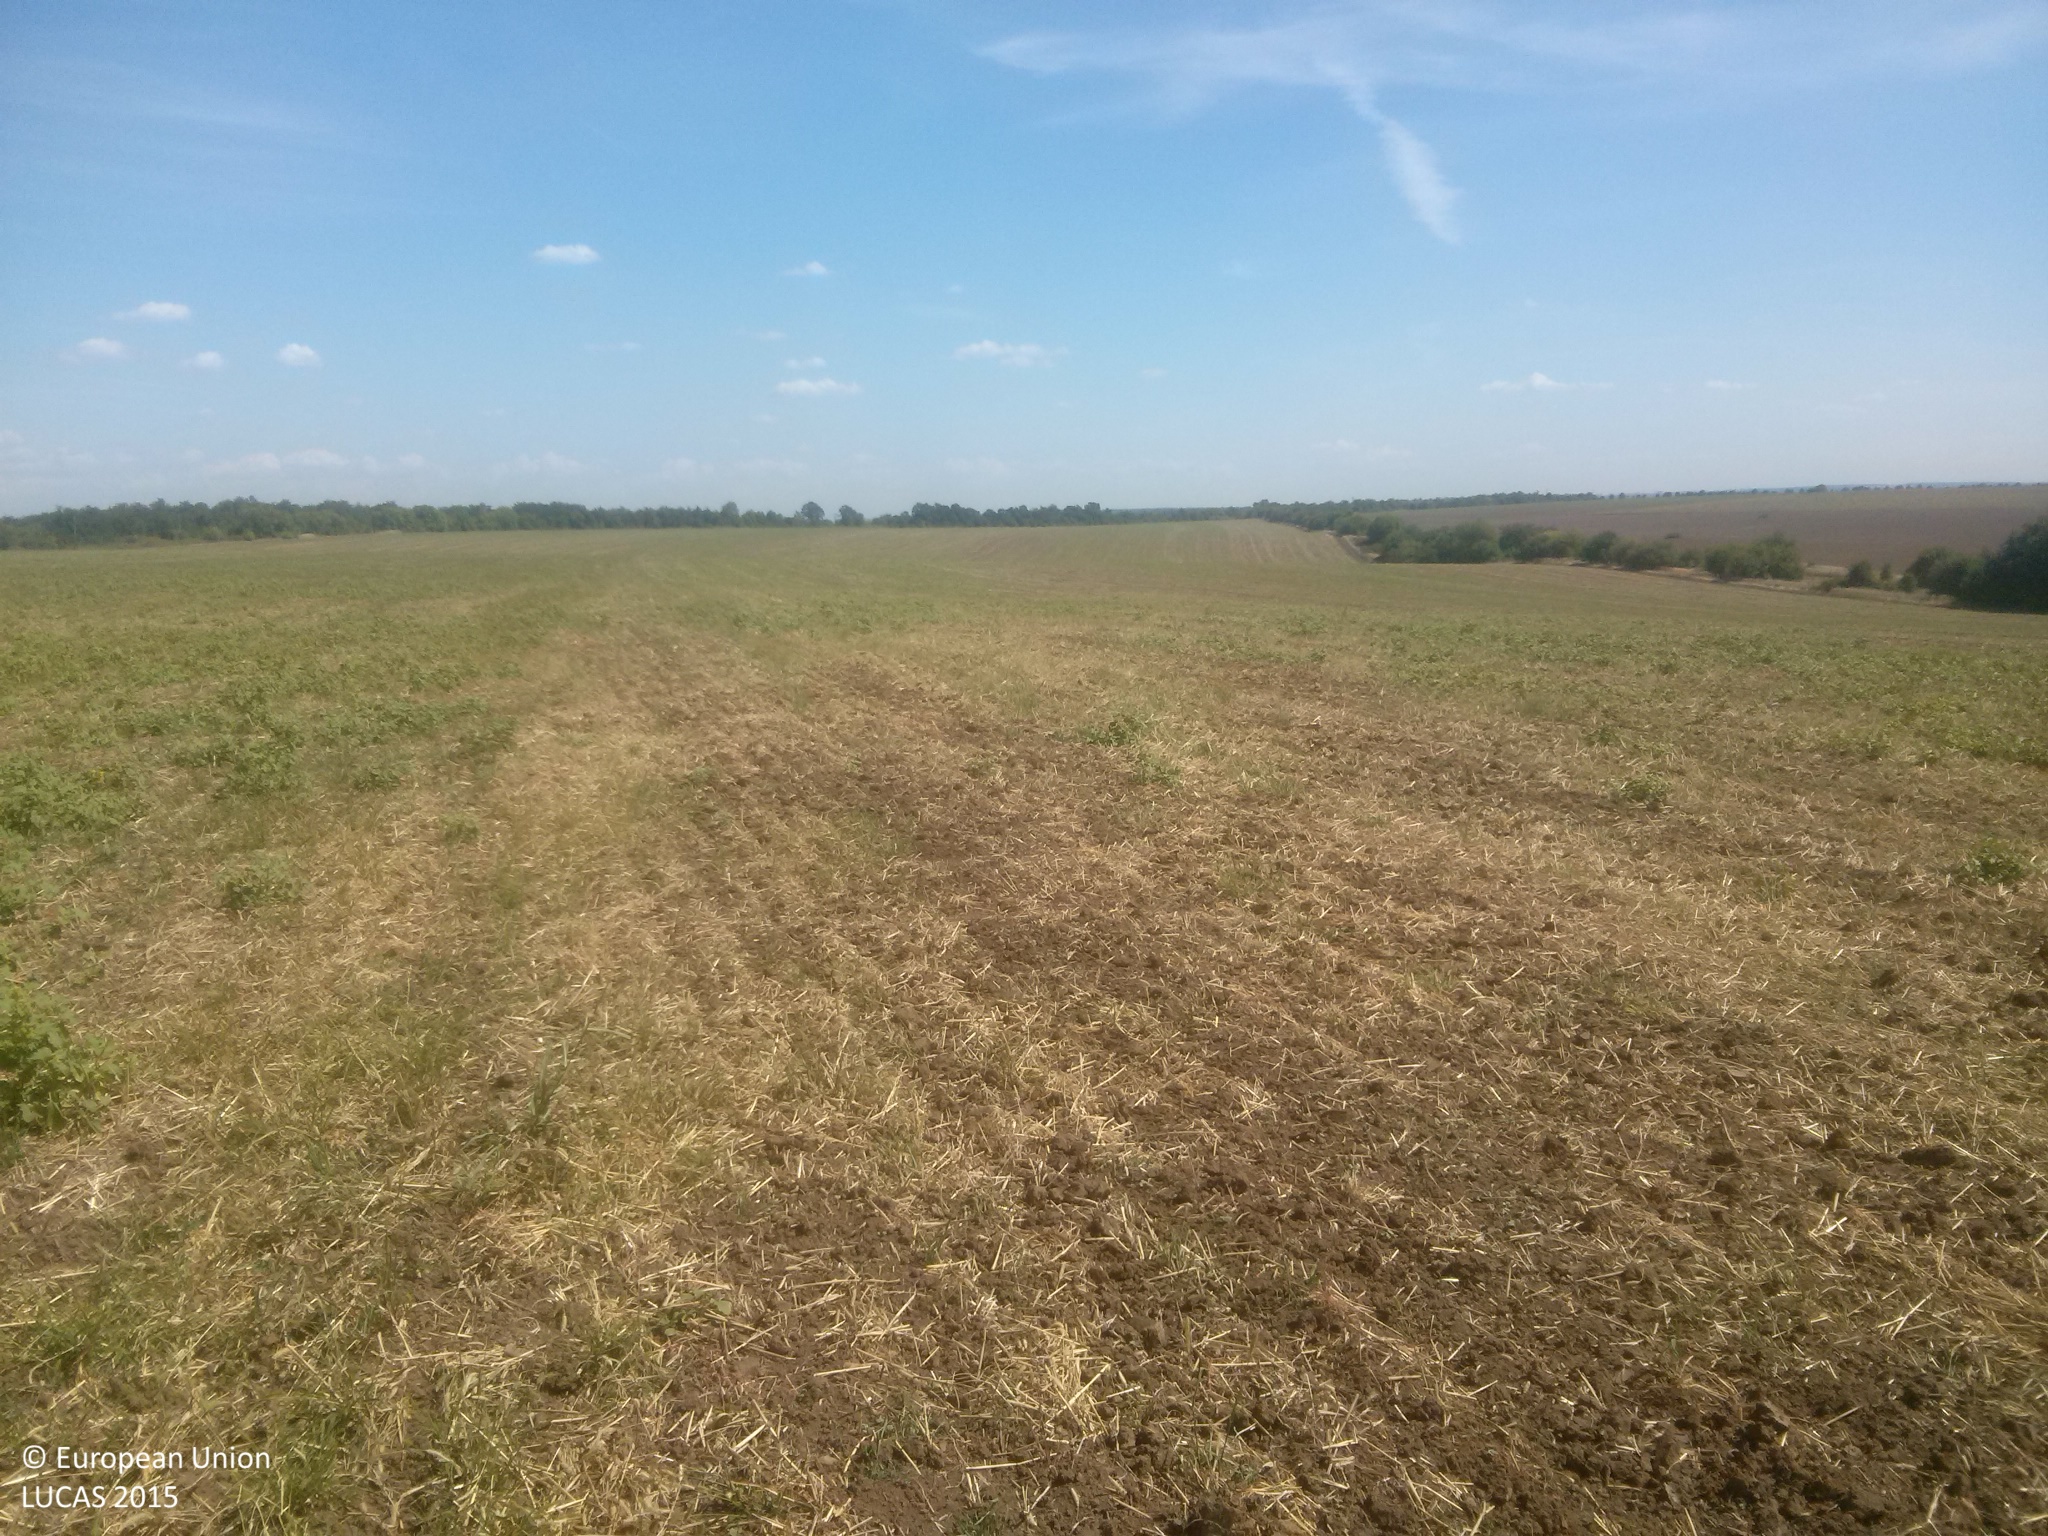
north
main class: Cropland
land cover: Common wheat
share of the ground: 10 - 25 %
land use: Agriculture (excluding fallow land and kitchen gardens)
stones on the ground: < 10 %
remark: Tilled/Sowed
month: September
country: BG
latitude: 43.6914
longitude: 26.3180
